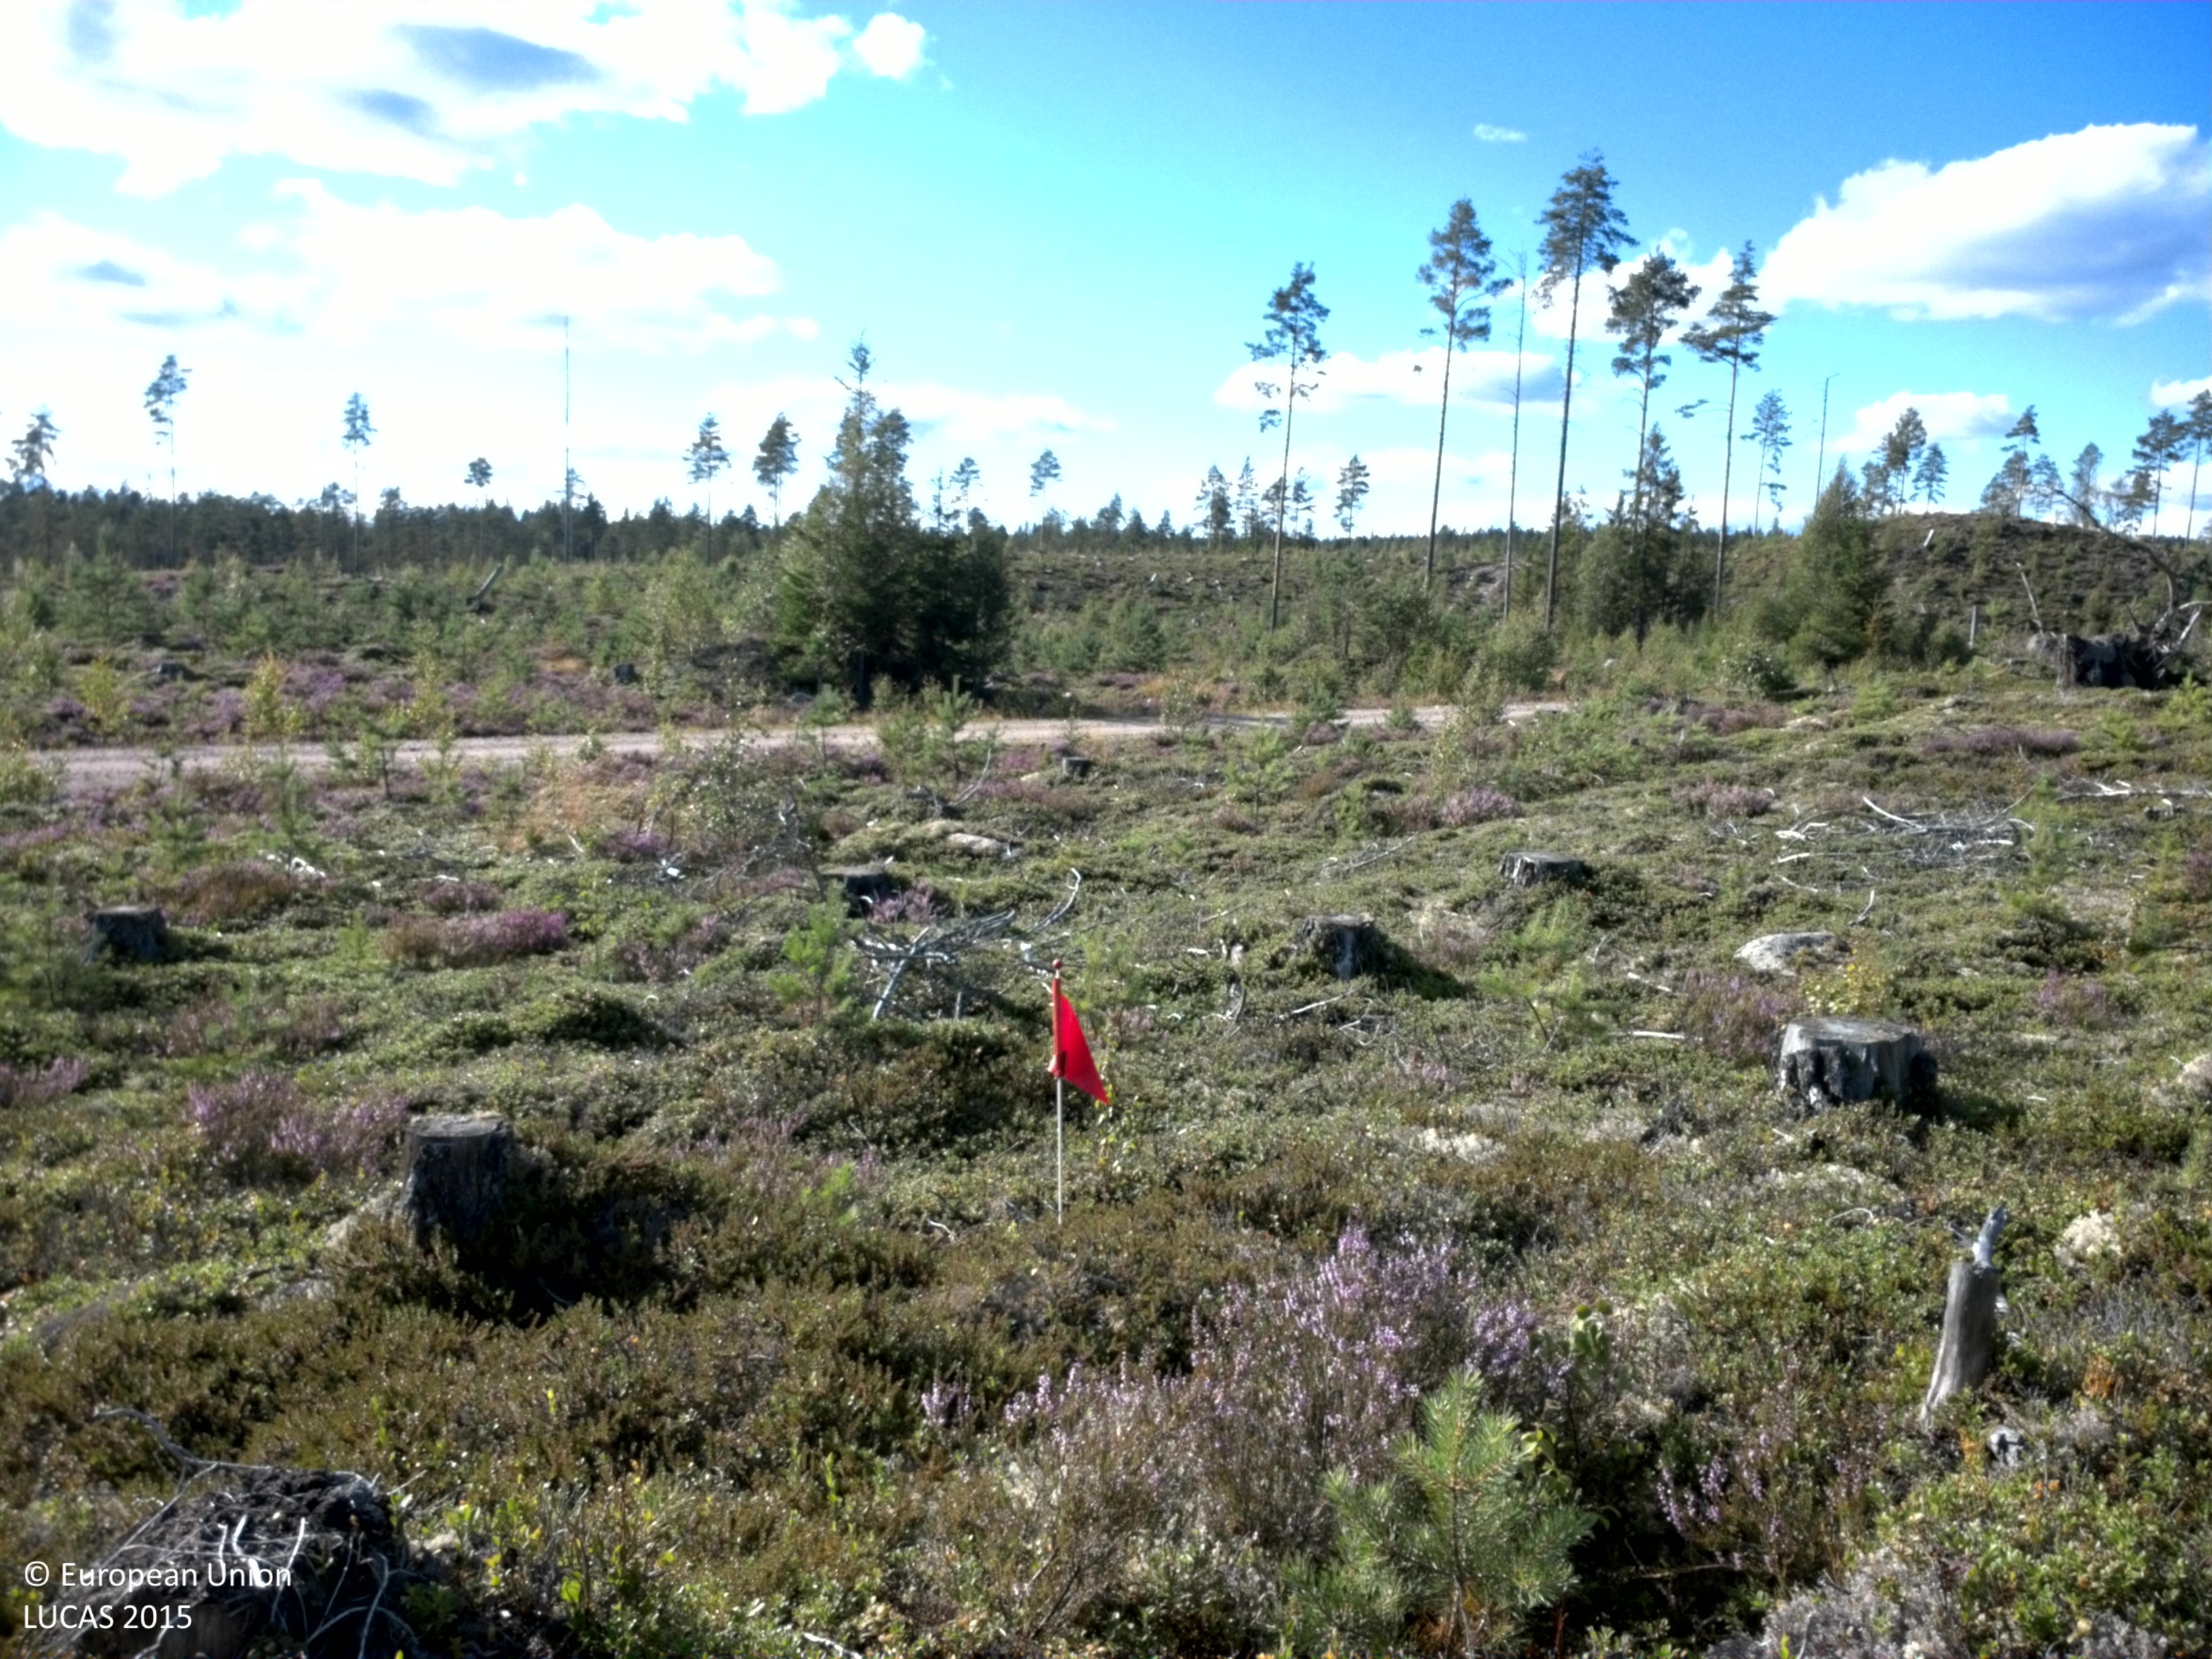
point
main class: Woodland
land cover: Pine dominated mixed woodland
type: boreal forest
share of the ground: 25 - 50 %
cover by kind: shrubs 45 %, lichens and mosses 20 %, coniferous forest trees 15 %, broadleaved forest trees 15 %, herbaceous plants 5 %
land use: Forestry
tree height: < 5 m
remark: Clear cut
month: August
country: SE
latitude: 60.2441
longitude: 13.5487
